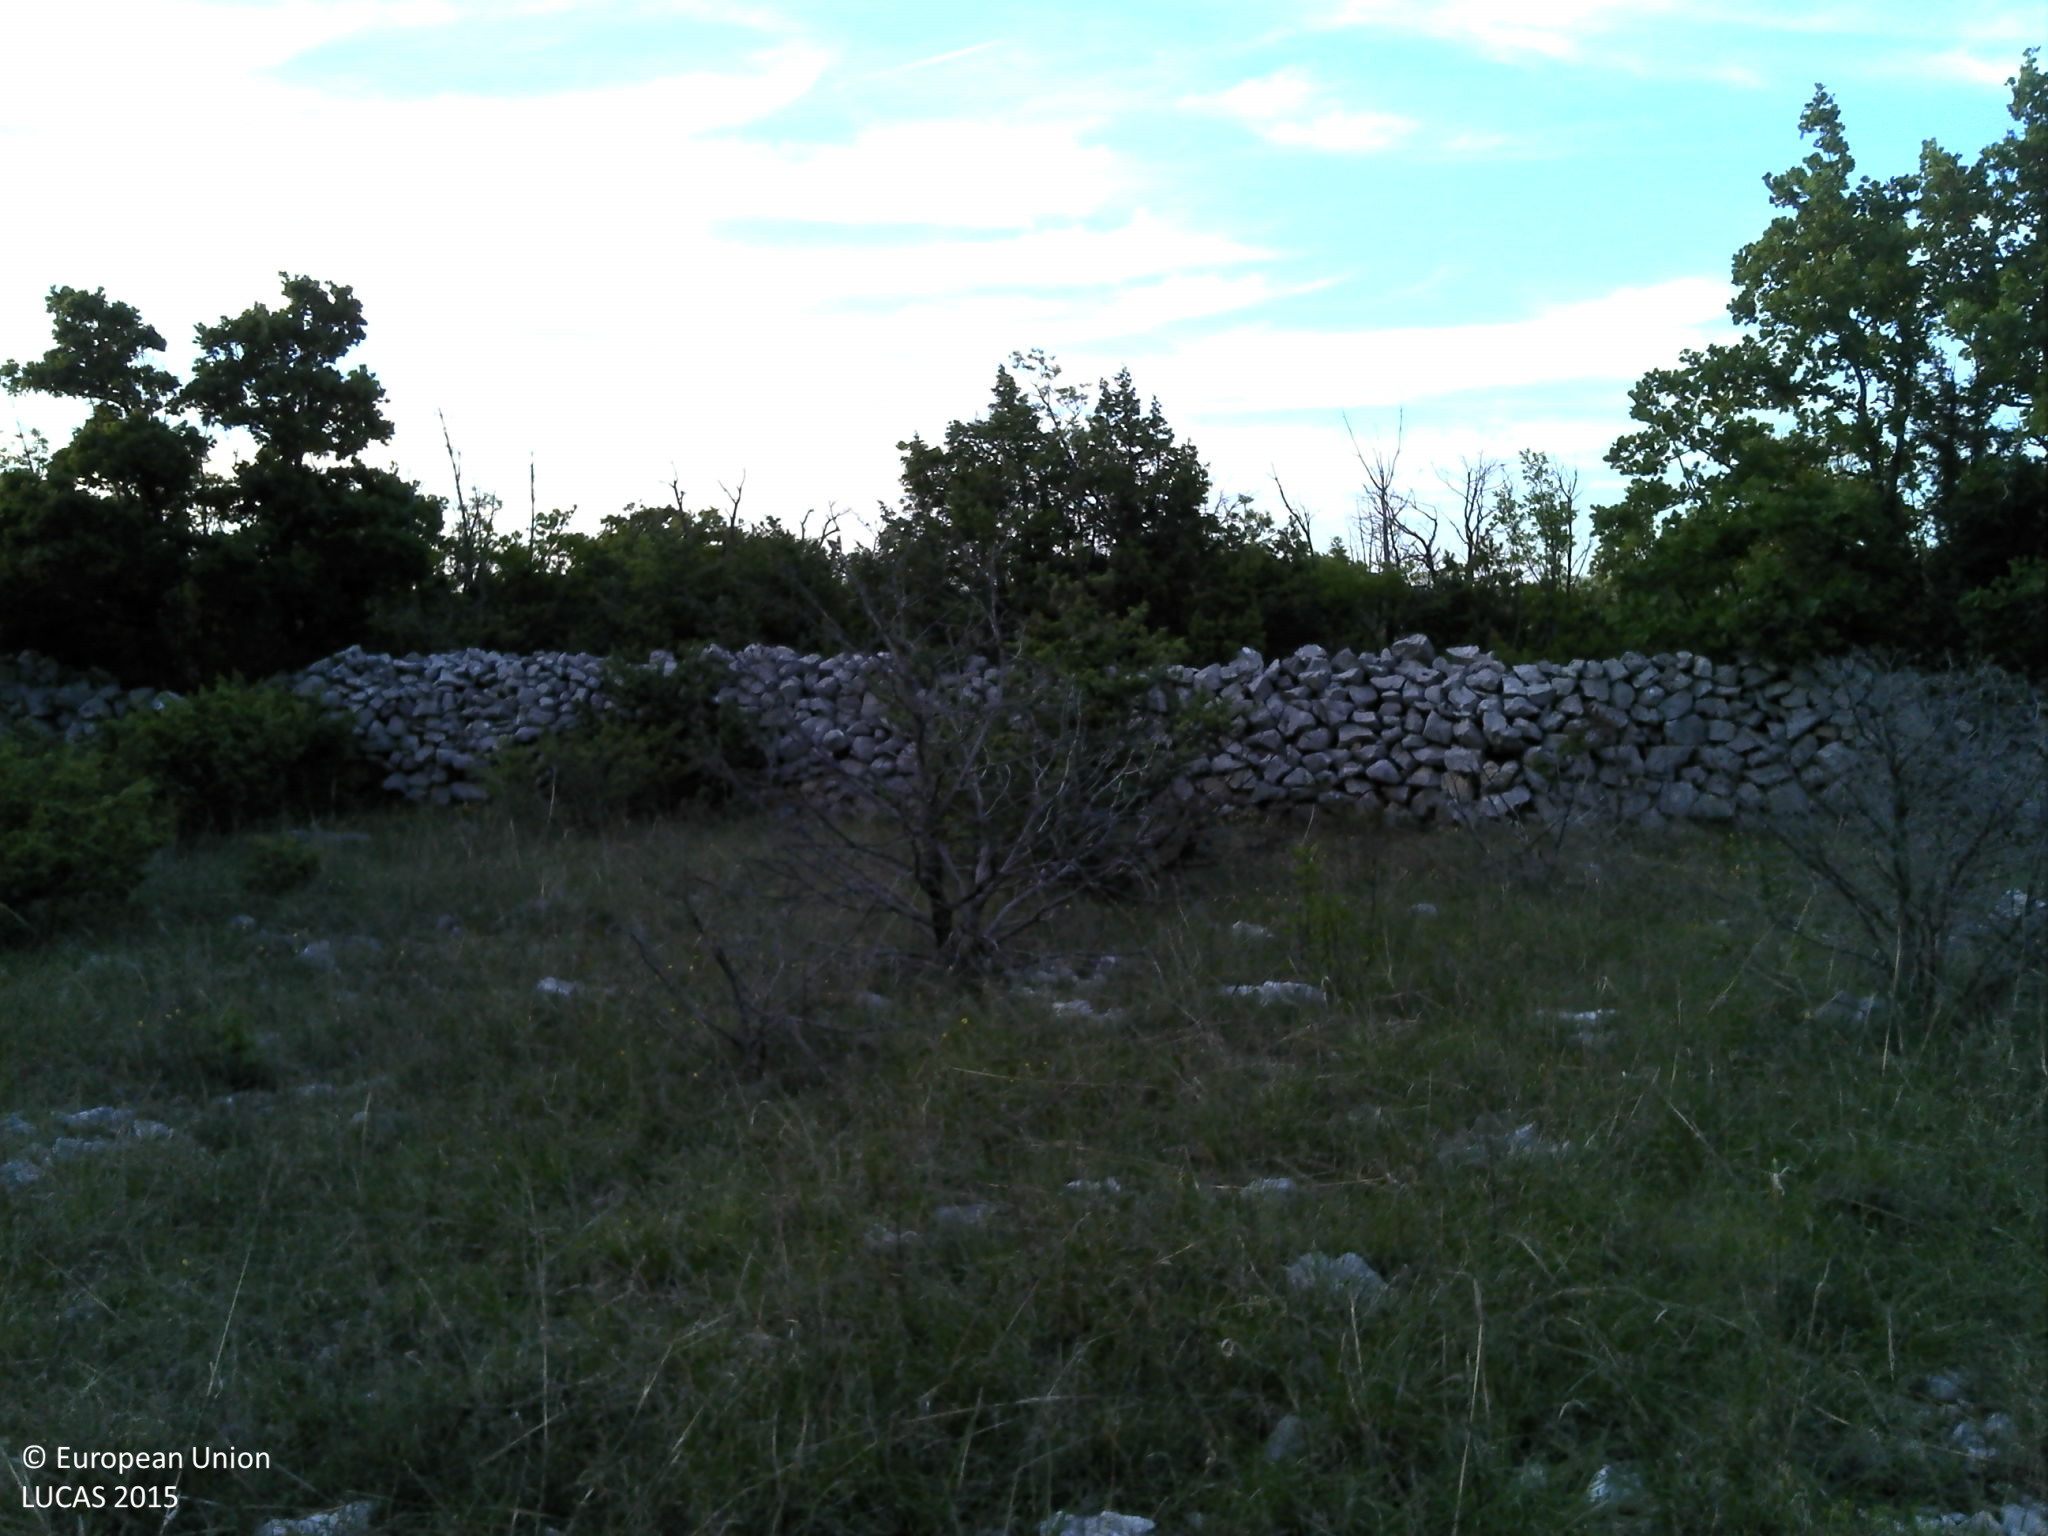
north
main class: Shrubland
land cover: Shrubland without tree cover
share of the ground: 25 - 50 %
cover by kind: herbaceous plants 45 %, shrubs 25 %, unconsolidated bare surface 20 %, consolidated bare surface 10 %
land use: Semi-natural and natural areas not in use
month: May
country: HR
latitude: 43.7795
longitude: 15.9926
